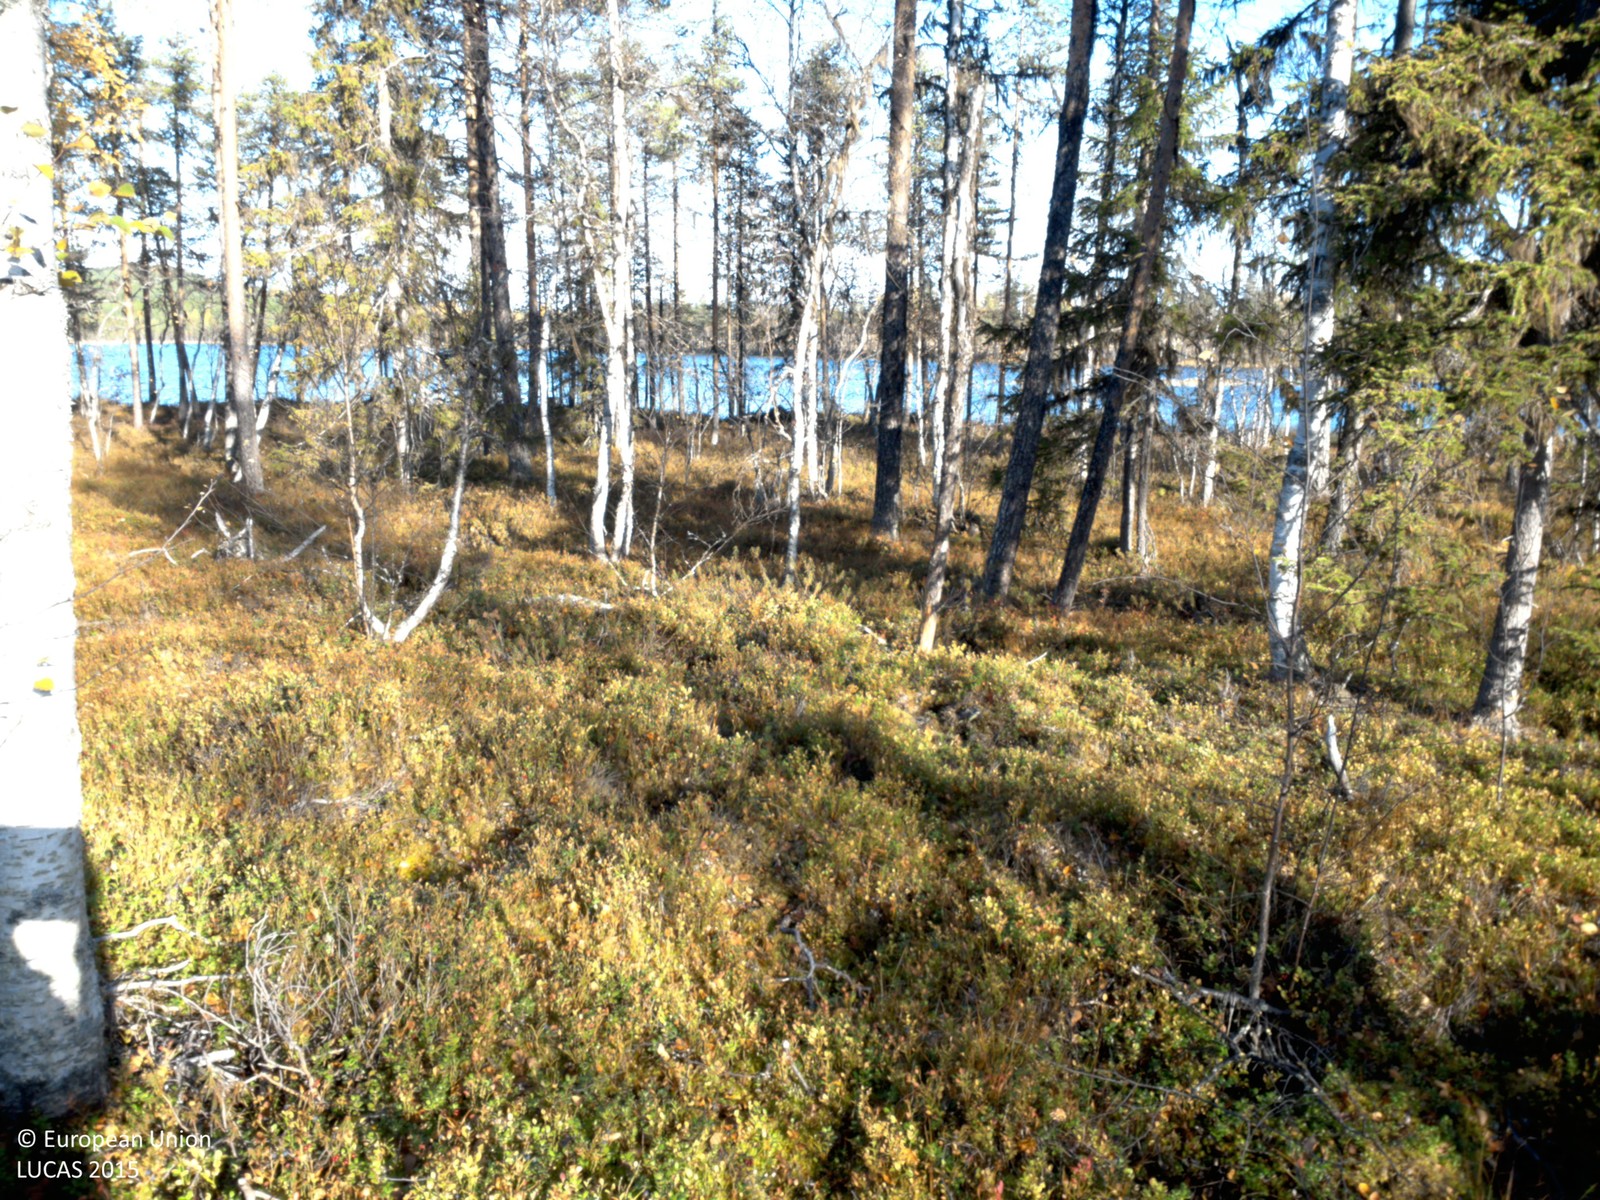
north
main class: Woodland
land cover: Broadleaved woodland
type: hemiboreal forest and nemoral coniferous forest and mixed broadleaved-coniferous forest
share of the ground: 50 - 75 %
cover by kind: broadleaved forest trees 50 %, shrubs 40 %, coniferous forest trees 5 %, lichens and mosses 5 %
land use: Forestry
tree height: > 5 m
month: September
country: SE
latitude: 64.8405
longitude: 18.5457
